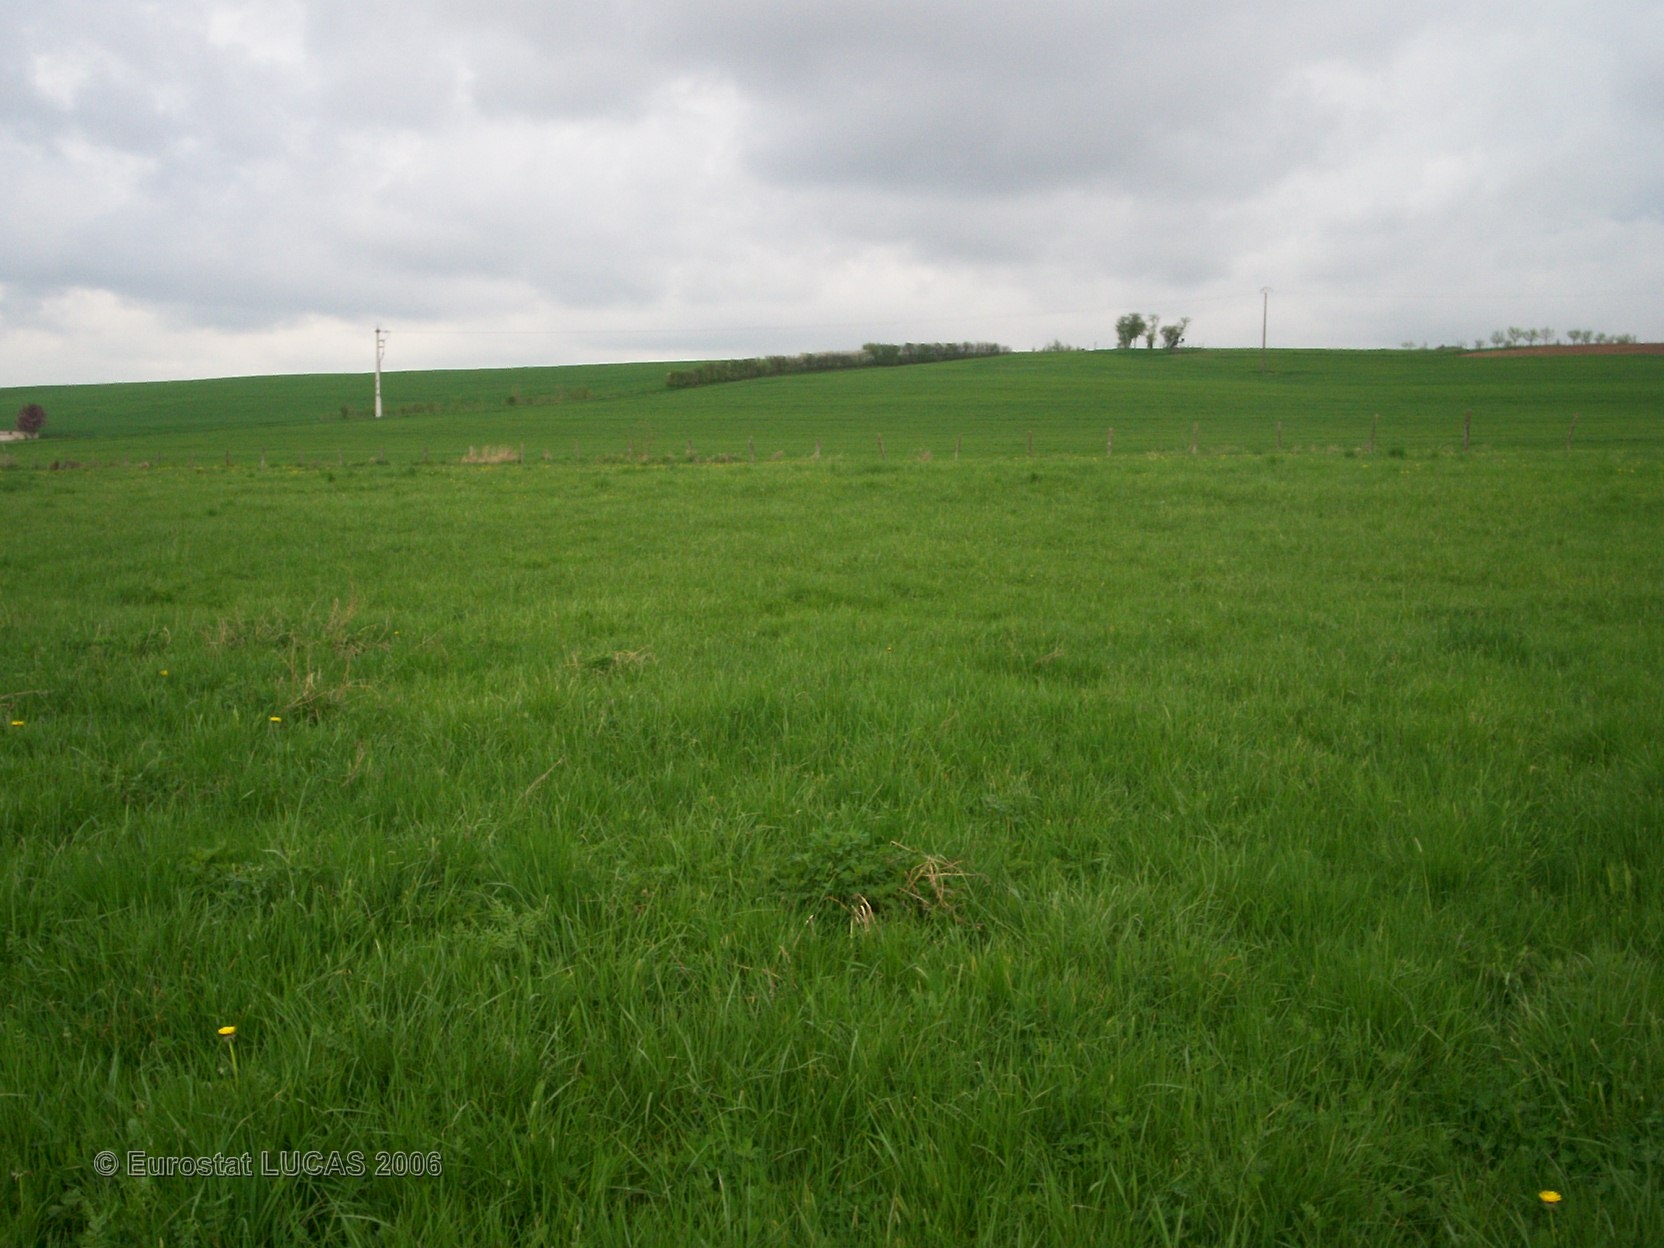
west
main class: Grassland
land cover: Grassland without tree/shrub cover
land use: Agriculture (excluding fallow land and kitchen gardens)
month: April
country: FR
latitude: 48.8058
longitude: 6.7462
